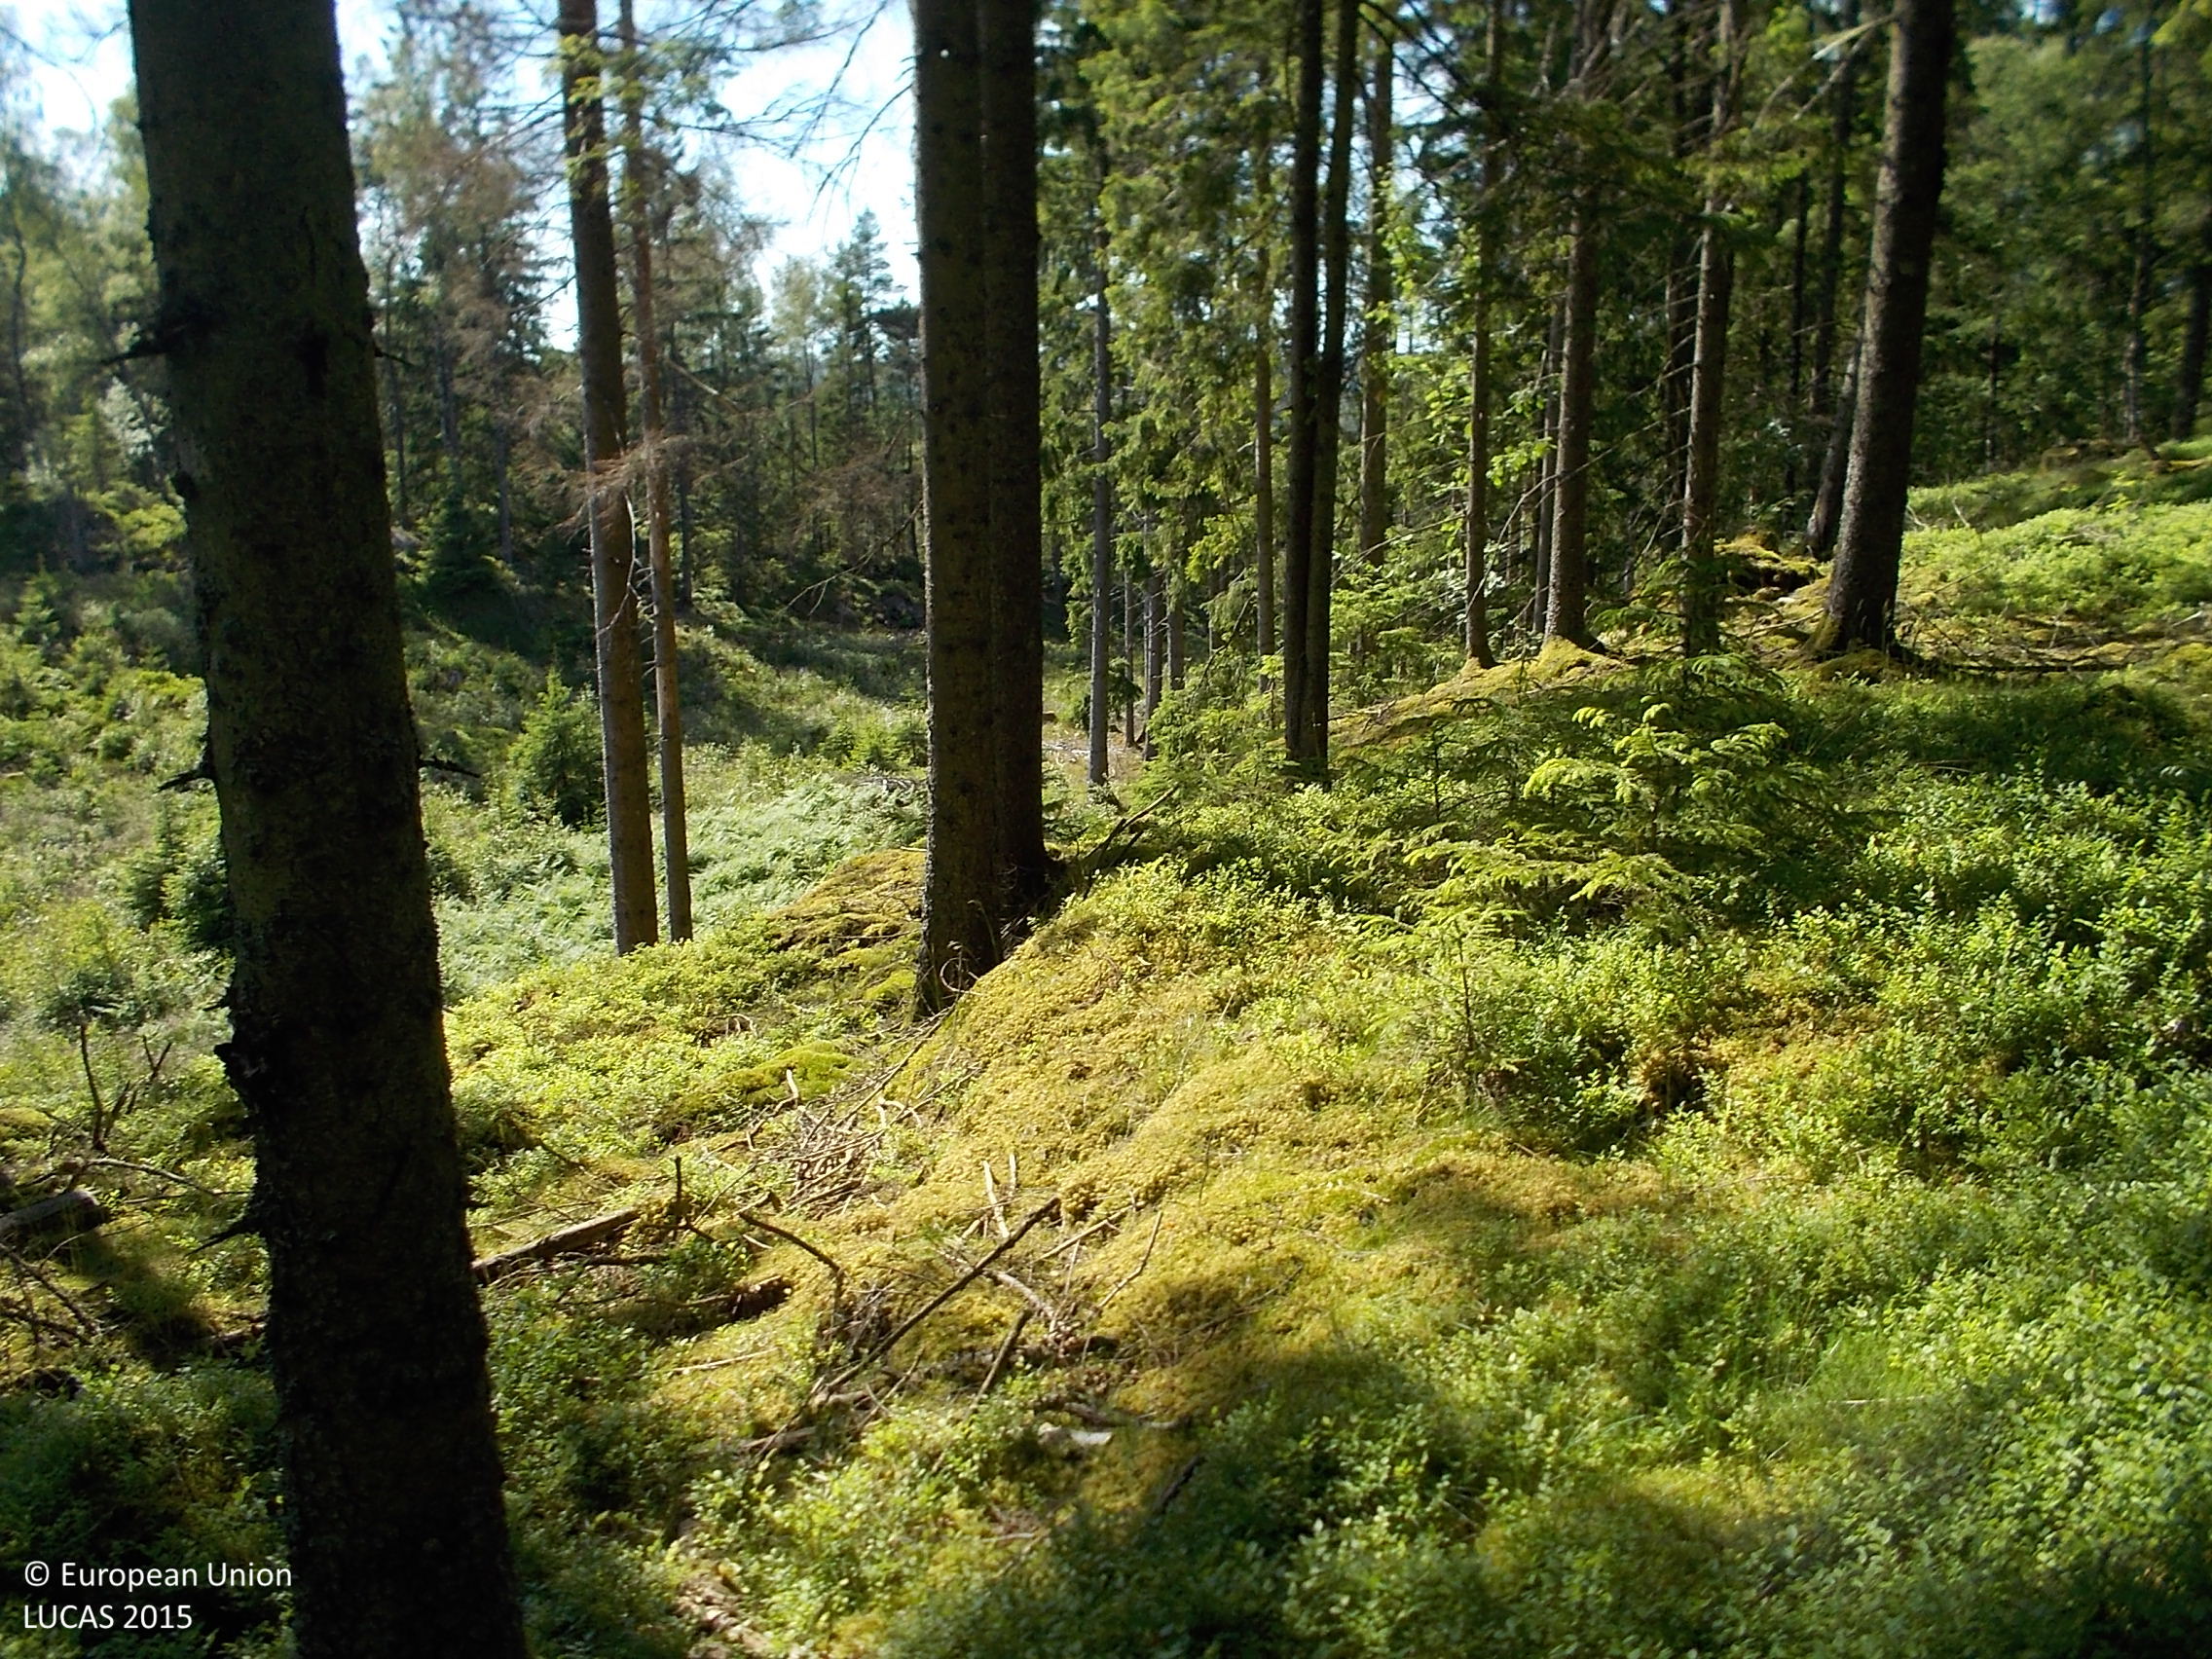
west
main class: Woodland
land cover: Spruce dominated coniferous woodland
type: boreal forest
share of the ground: 50 - 75 %
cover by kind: coniferous forest trees 70 %, shrubs 25 %, herbaceous plants 5 %
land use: Forestry
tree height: > 5 m
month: June
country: SE
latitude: 57.3566
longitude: 13.0710
